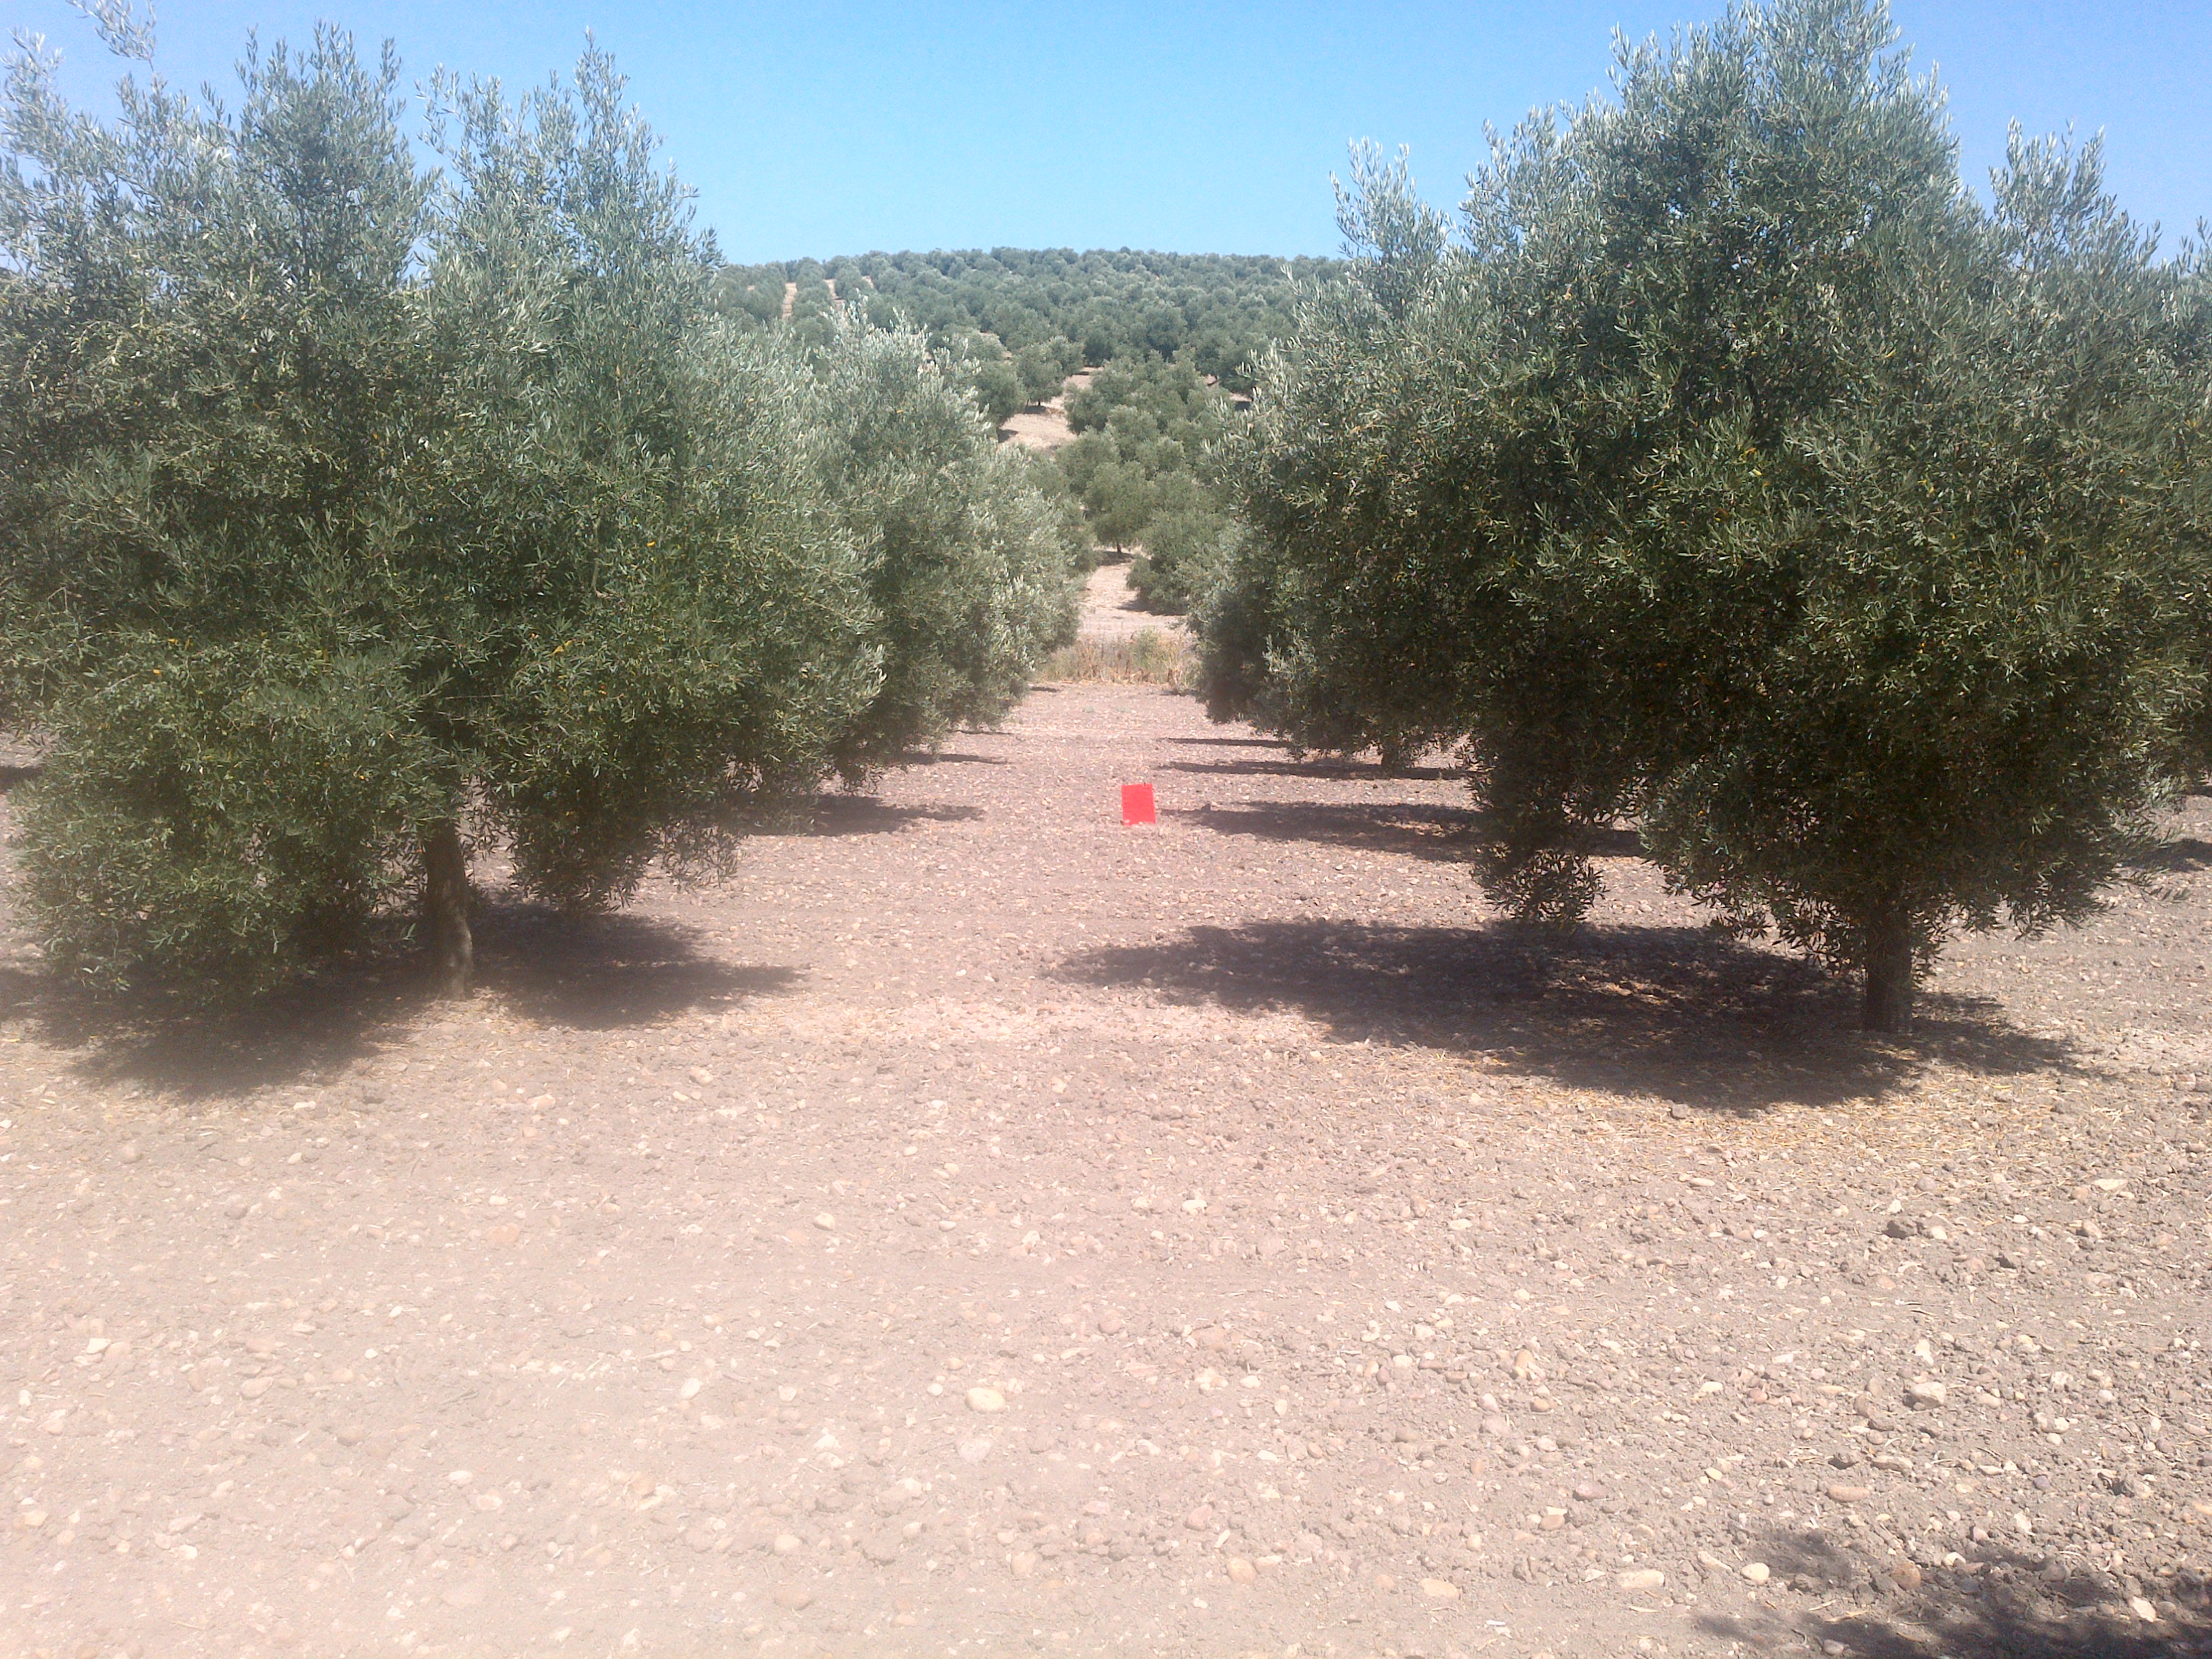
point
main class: Cropland
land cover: Olive groves
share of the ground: 50 - 75 %
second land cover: Other bare soil
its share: > 75 %
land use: Agriculture (excluding fallow land and kitchen gardens)
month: June
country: ES
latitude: 37.5997
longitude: -4.8828
